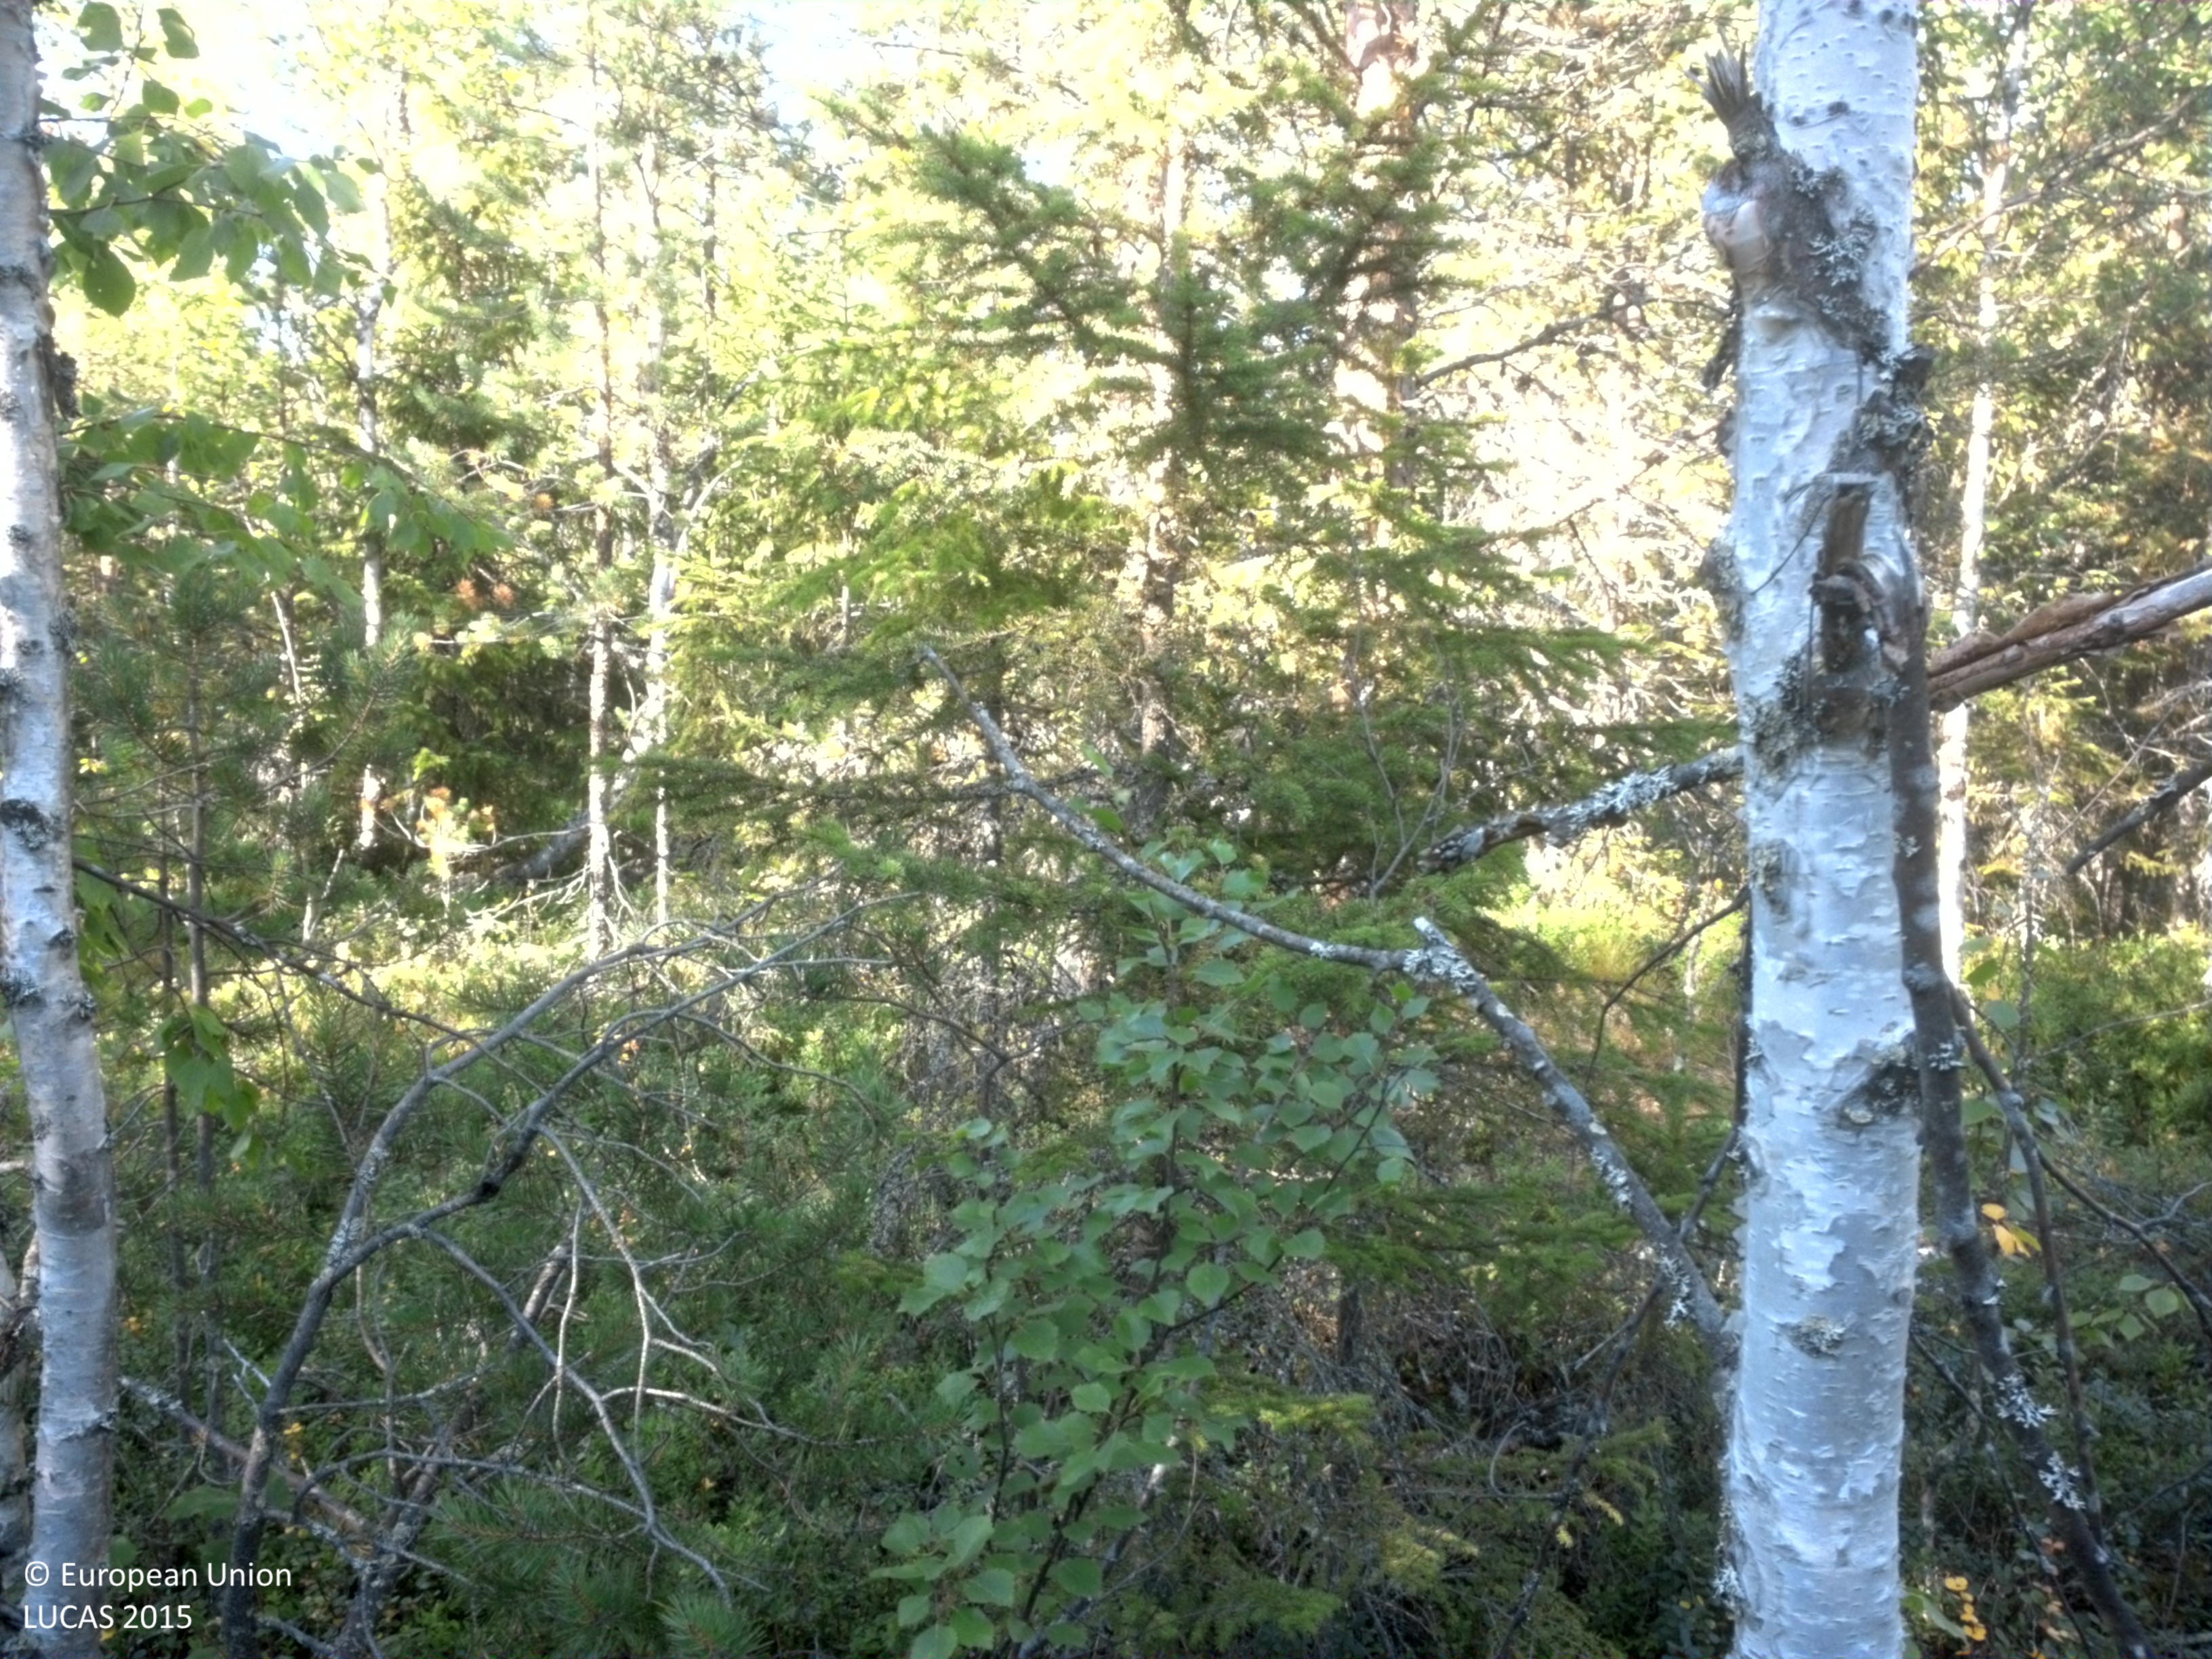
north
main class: Woodland
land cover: Spruce dominated mixed woodland
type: boreal forest
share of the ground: 50 - 75 %
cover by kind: shrubs 40 %, coniferous forest trees 35 %, broadleaved forest trees 15 %, herbaceous plants 5 %, lichens and mosses 5 %
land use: Forestry
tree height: > 5 m
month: August
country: SE
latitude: 64.5742
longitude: 18.4220
